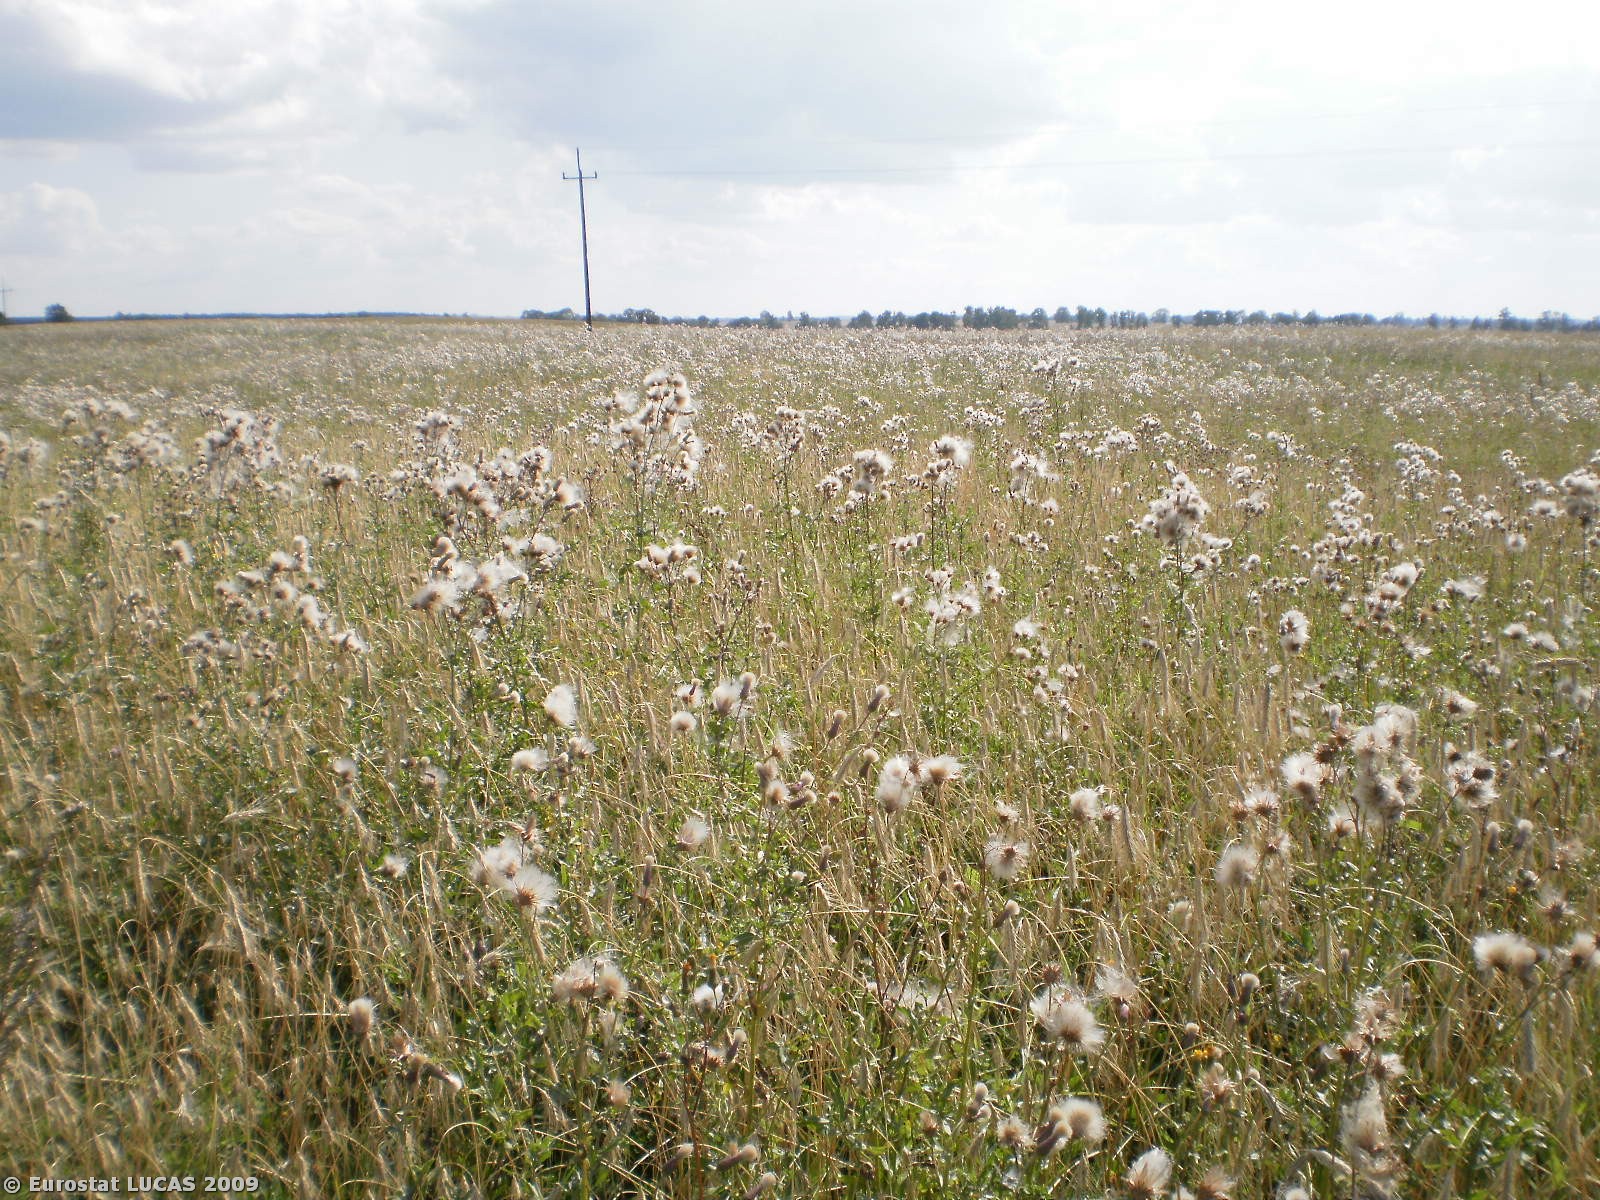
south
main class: Grassland
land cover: Spontaneously vegetated surfaces
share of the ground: > 75 %
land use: Fallow land
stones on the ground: < 10 %
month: August
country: PL
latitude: 54.0447
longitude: 21.1782
